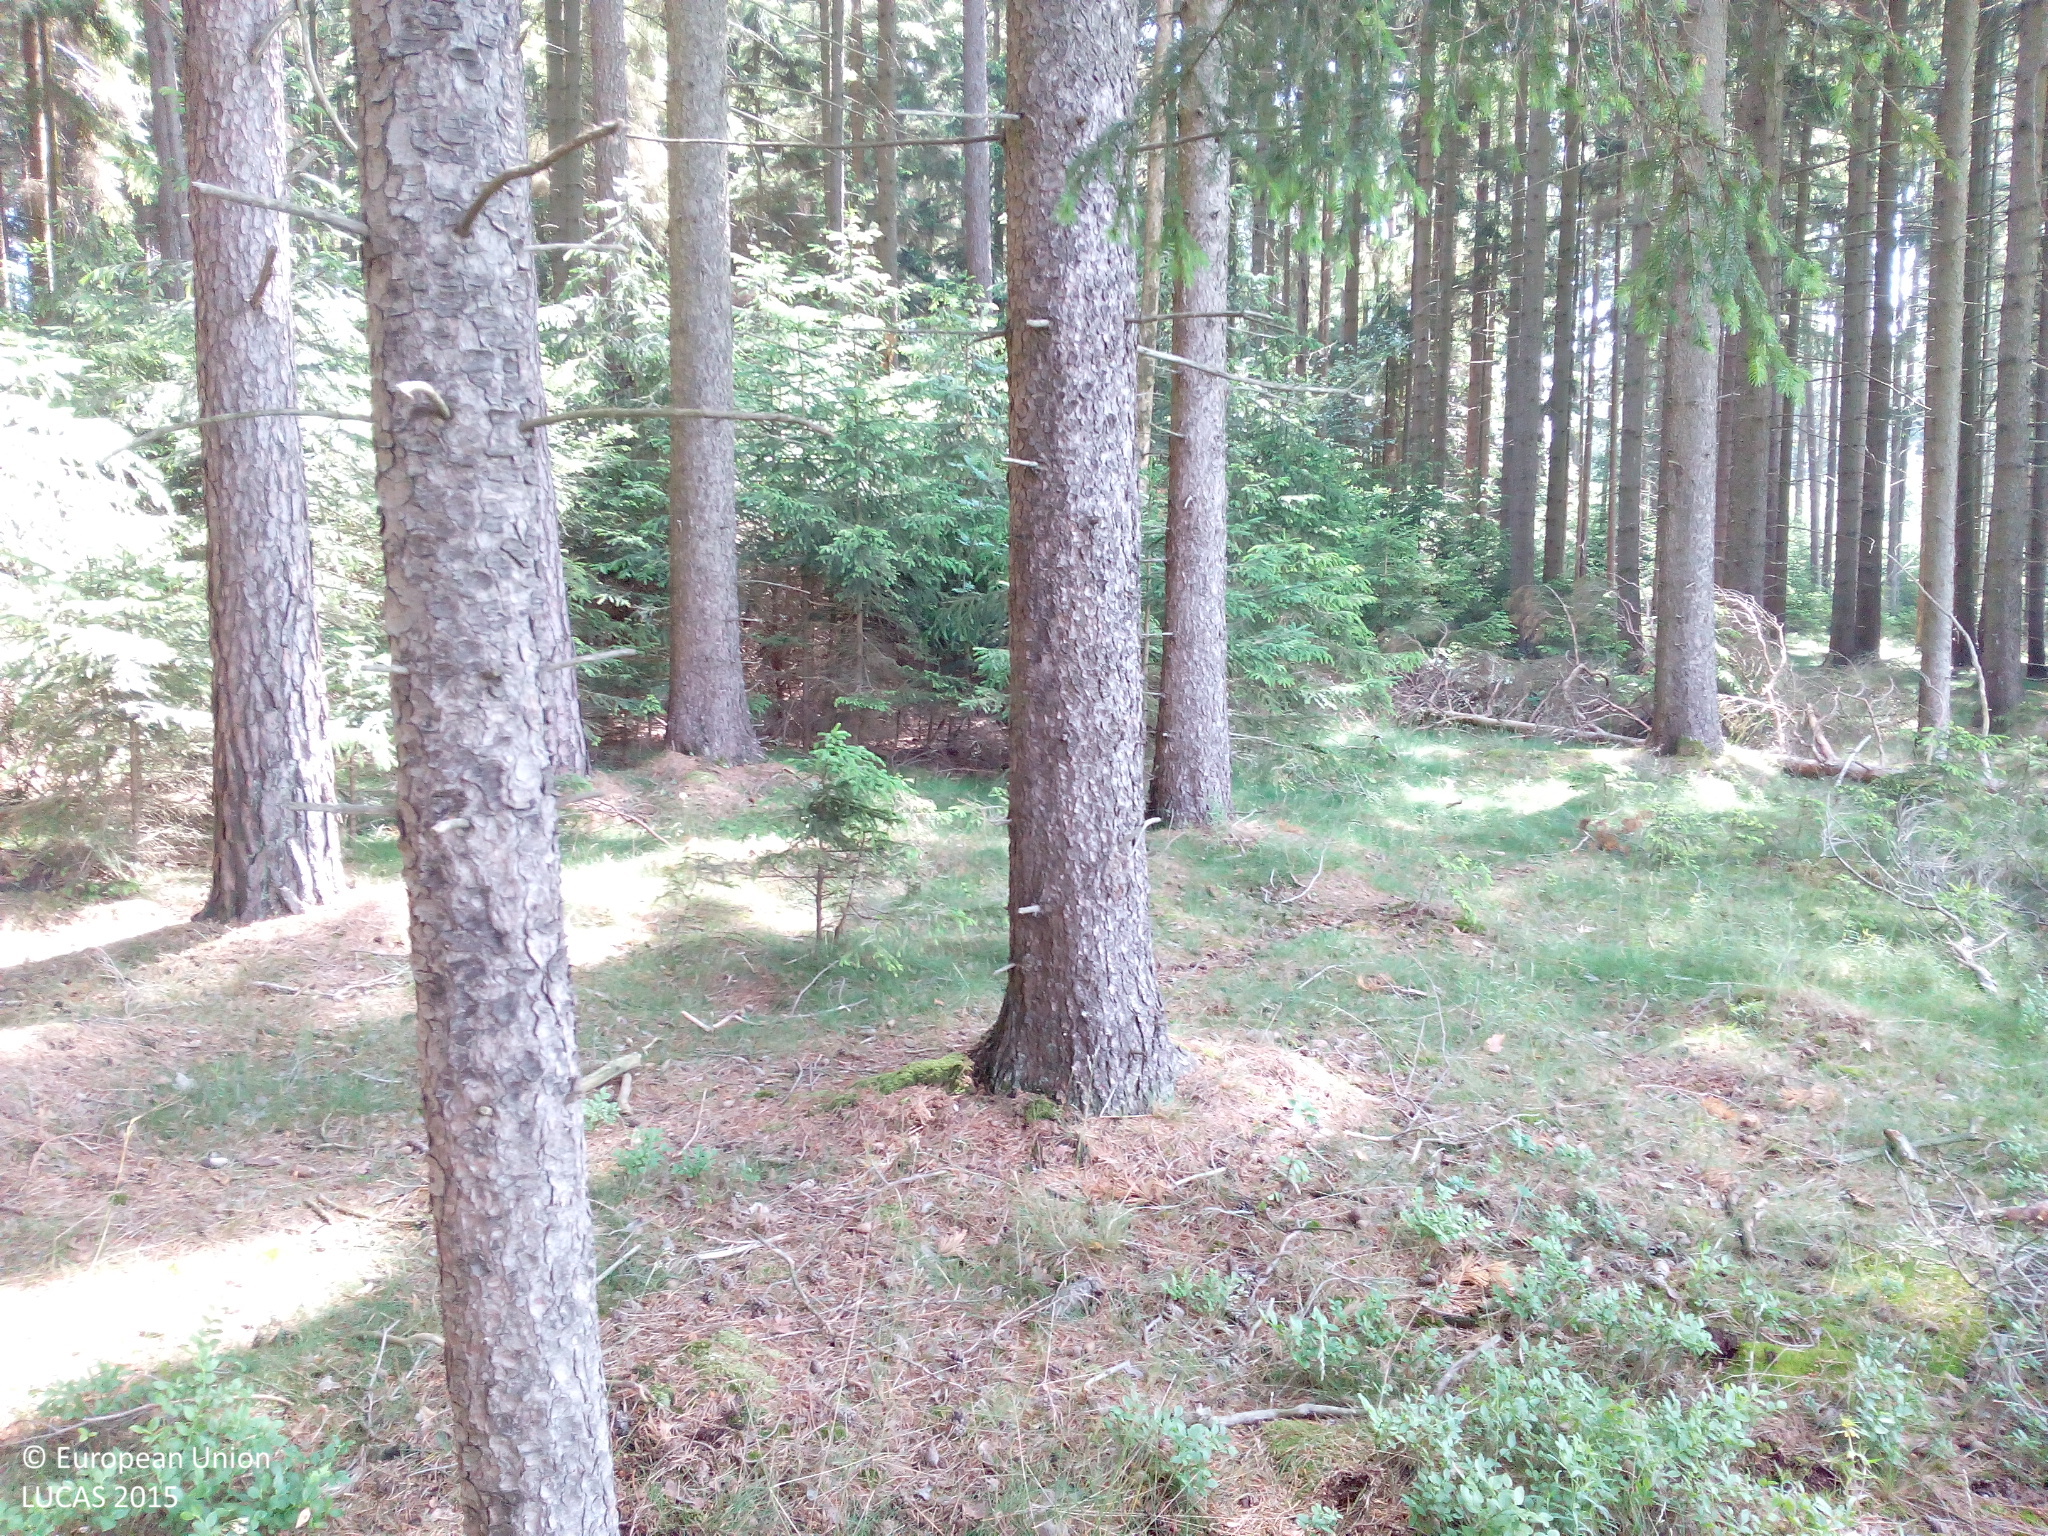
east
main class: Woodland
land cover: Other coniferous woodland
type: hemiboreal forest and nemoral coniferous forest and mixed broadleaved-coniferous forest
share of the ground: > 75 %
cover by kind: coniferous forest trees 80 %, shrubs 5 %, herbaceous plants 5 %, lichens and mosses 5 %, unconsolidated bare surface 5 %
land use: Forestry
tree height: > 5 m
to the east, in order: Other coniferous woodland; Grass margins; Tracks; Grass margins; Spruce dominated coniferous woodland; Grassland without tree/shrub cover
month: June
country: DE
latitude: 49.9070
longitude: 12.4085
